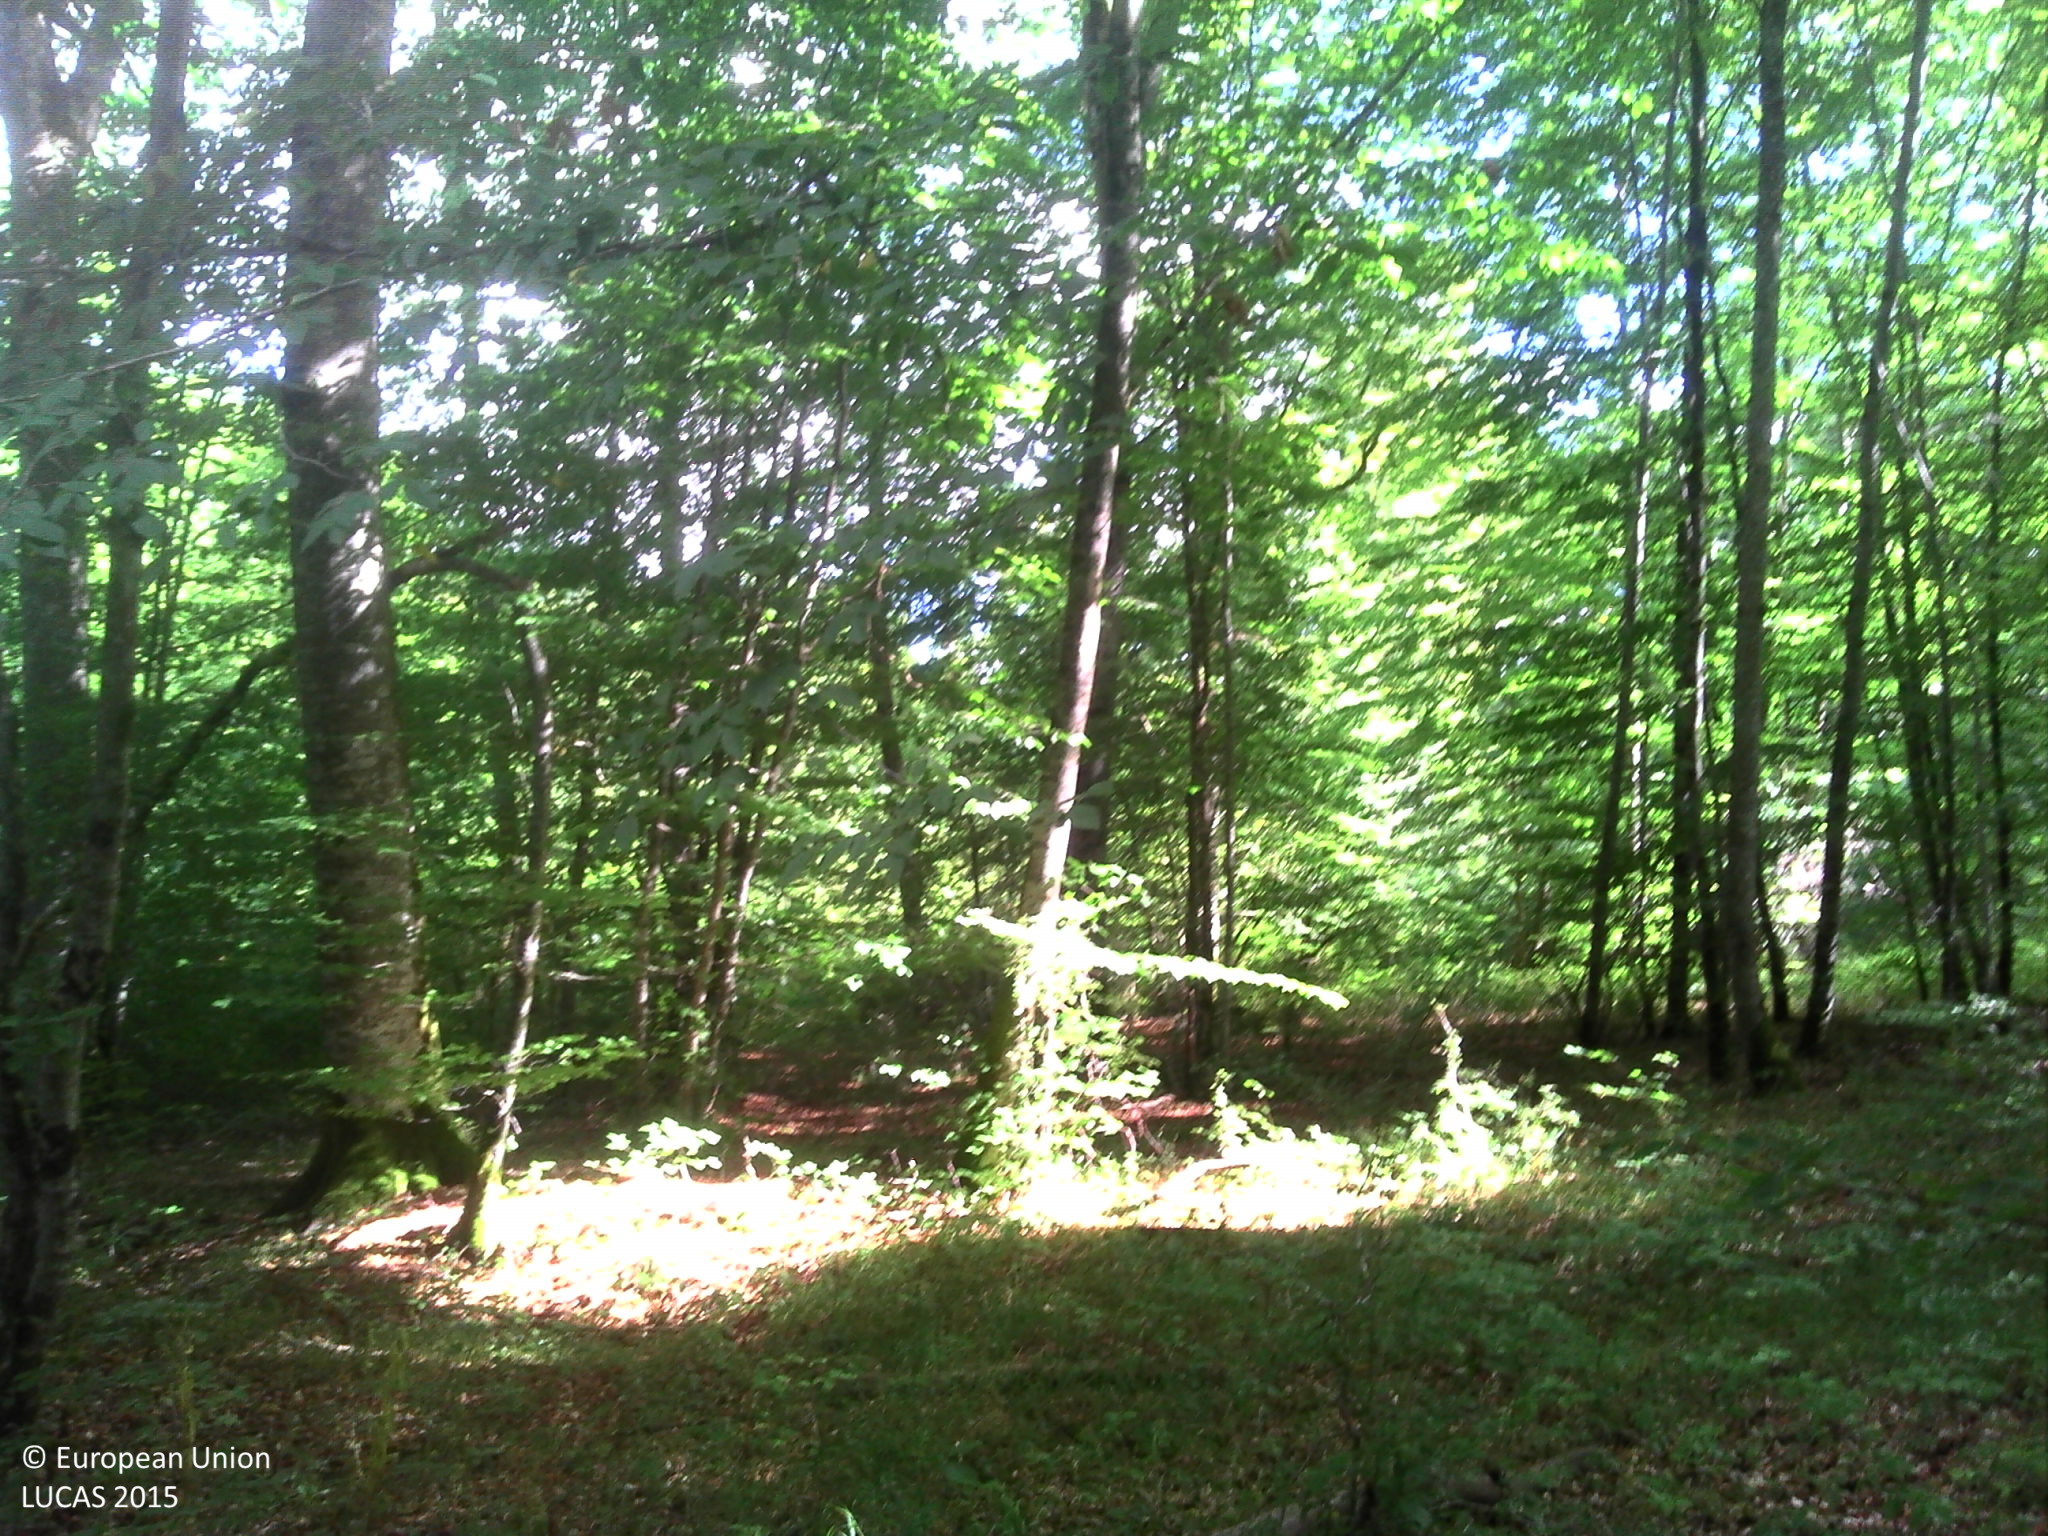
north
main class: Woodland
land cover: Broadleaved woodland
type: acidophilous oak and oak-birch forest
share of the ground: > 75 %
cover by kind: broadleaved forest trees 80 %, herbaceous plants 10 %, lichens and mosses 10 %
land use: Forestry
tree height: > 5 m
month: July
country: FR
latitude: 47.9685
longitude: 5.0568
